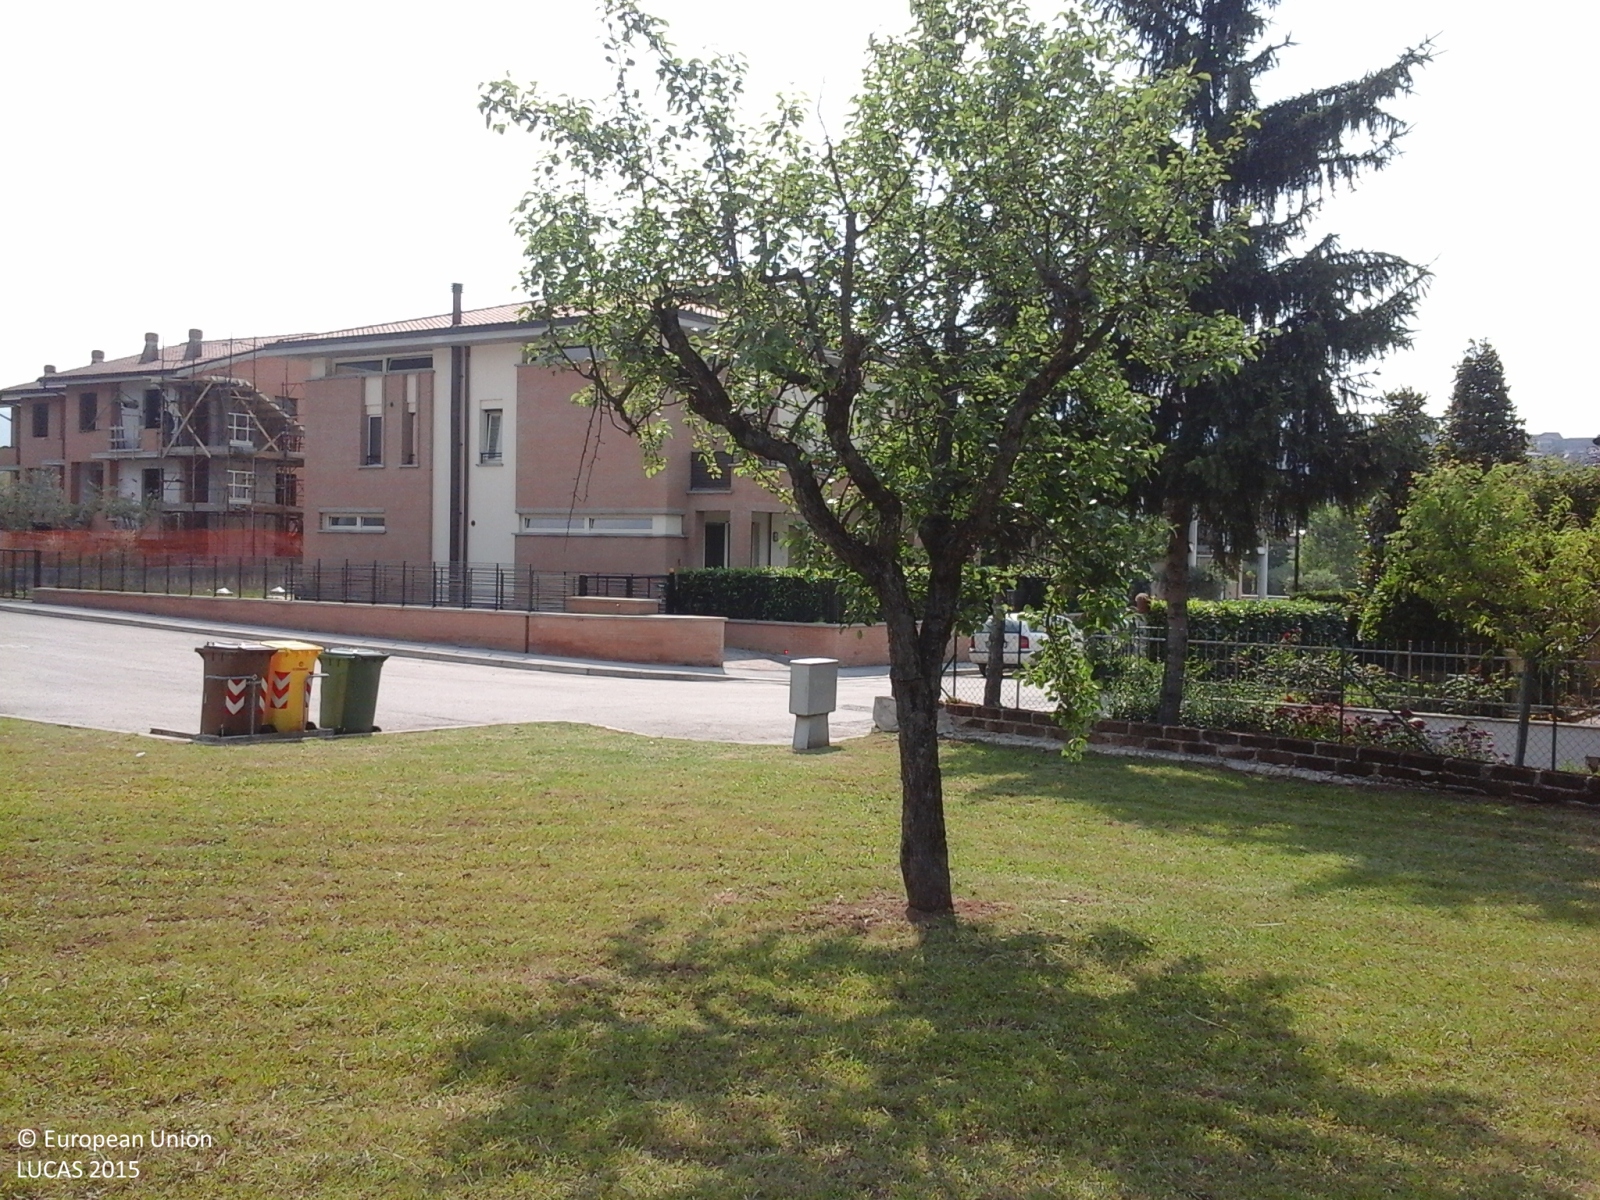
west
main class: Grassland
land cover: Grassland with sparse tree/shrub cover
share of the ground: > 75 %
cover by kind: herbaceous plants 95 %, broadleaved forest trees 5 %
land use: Agriculture (excluding fallow land and kitchen gardens)
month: June
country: IT
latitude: 43.1620
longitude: 13.2505
